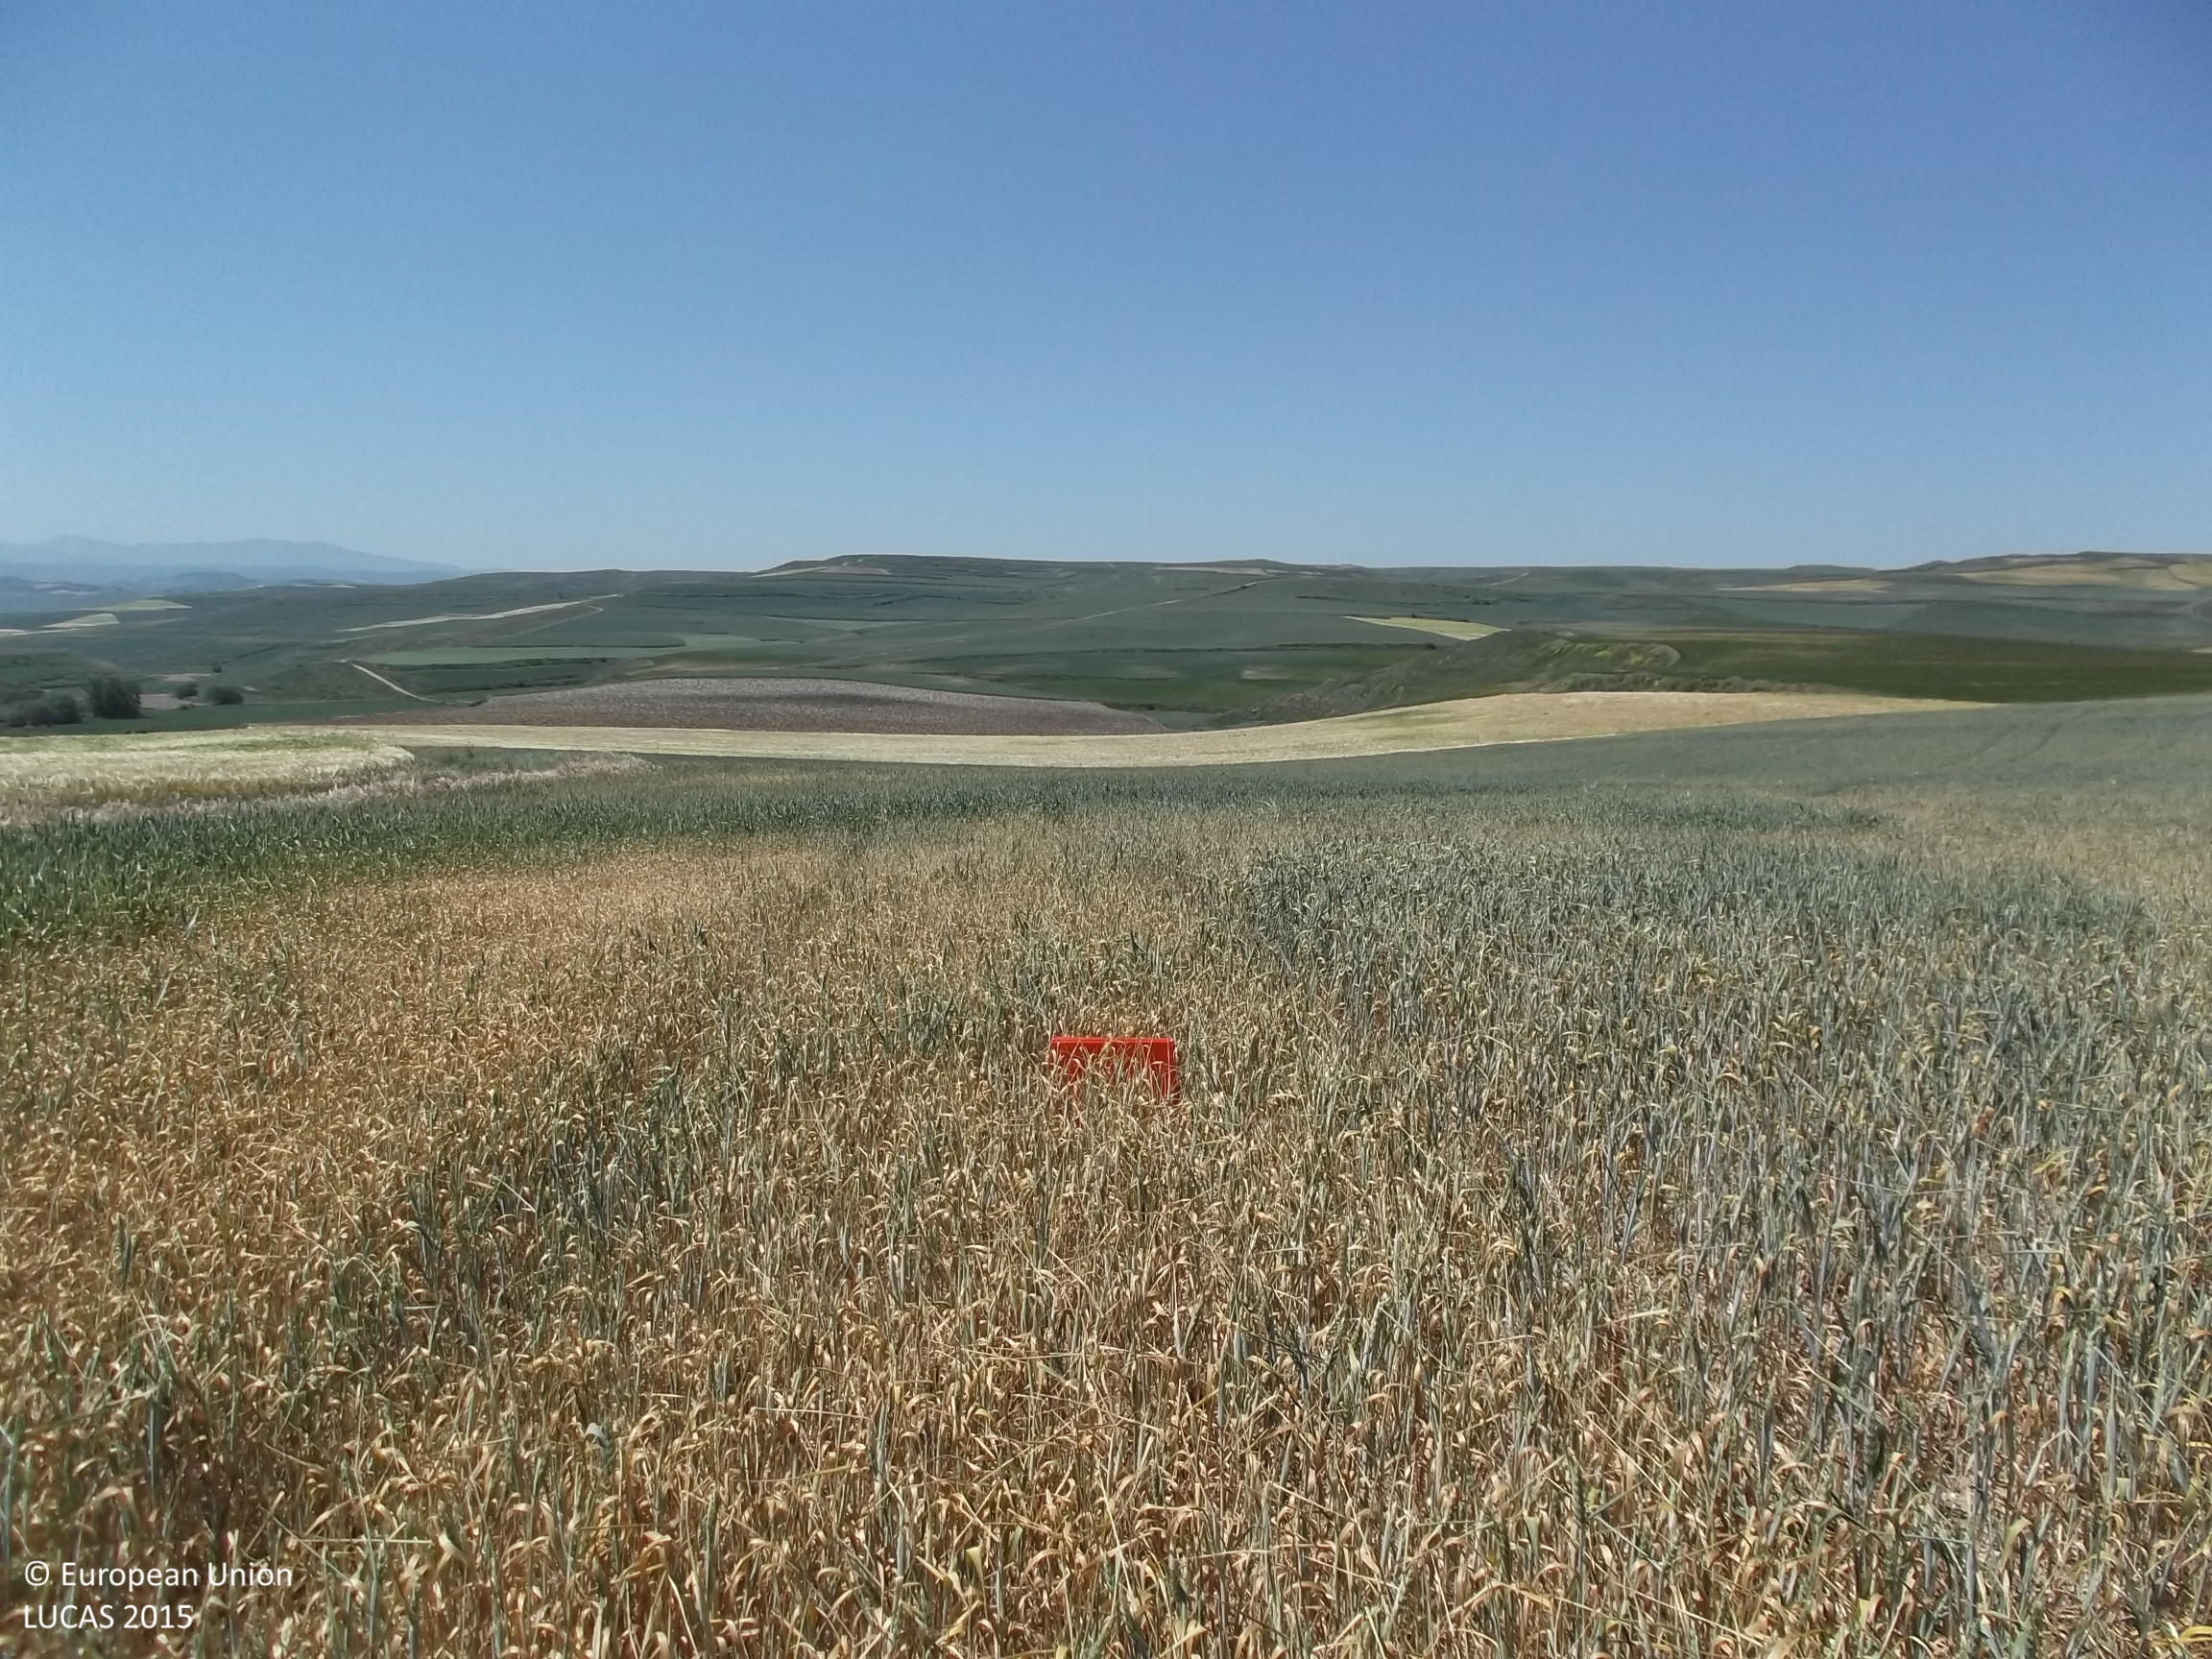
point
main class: Cropland
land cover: Common wheat
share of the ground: > 75 %
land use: Agriculture (excluding fallow land and kitchen gardens)
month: May
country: ES
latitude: 42.5340
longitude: -3.0687
